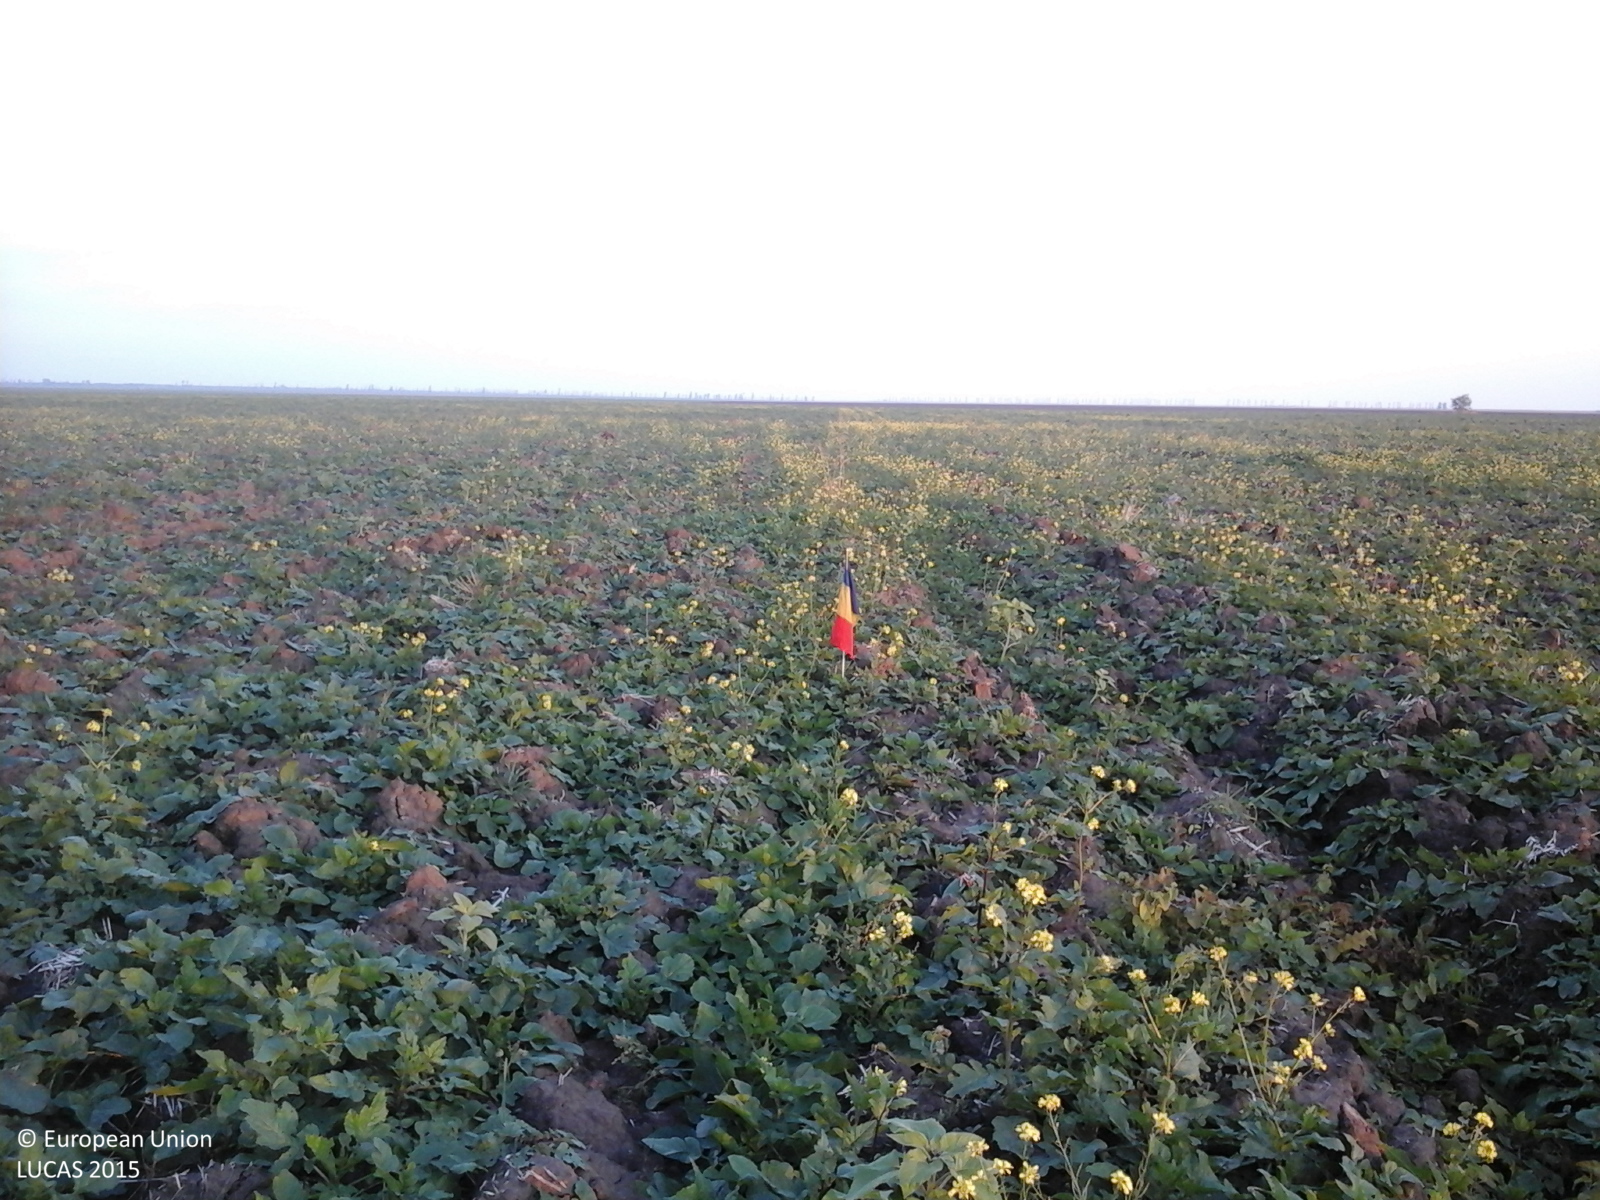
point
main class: Grassland
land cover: Spontaneously vegetated surfaces
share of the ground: > 75 %
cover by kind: herbaceous plants 100 %
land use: Fallow land
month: October
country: RO
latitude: 45.2461
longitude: 27.0445
